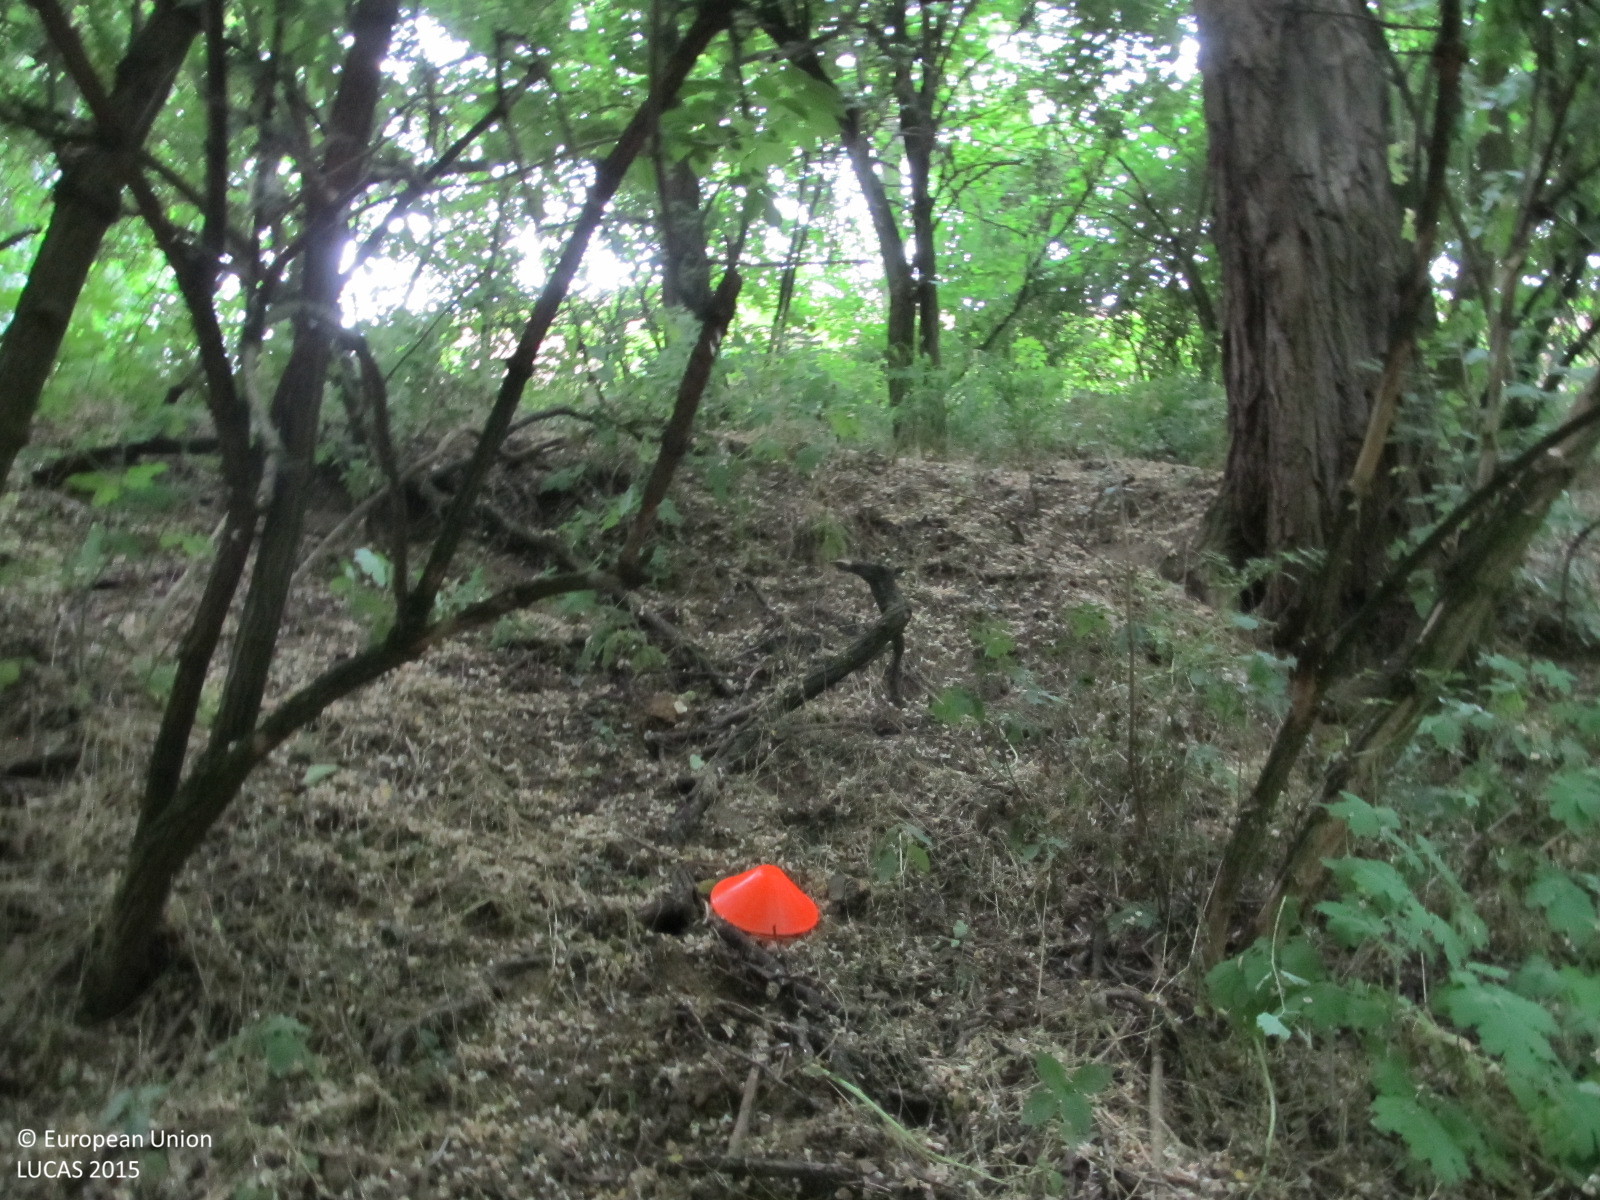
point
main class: Woodland
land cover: Broadleaved woodland
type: exotic forest
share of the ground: > 75 %
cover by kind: broadleaved forest trees 80 %, shrubs 10 %, herbaceous plants 10 %
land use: Semi-natural and natural areas not in use
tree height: > 5 m
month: June
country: AT
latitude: 48.2659
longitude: 15.8637
